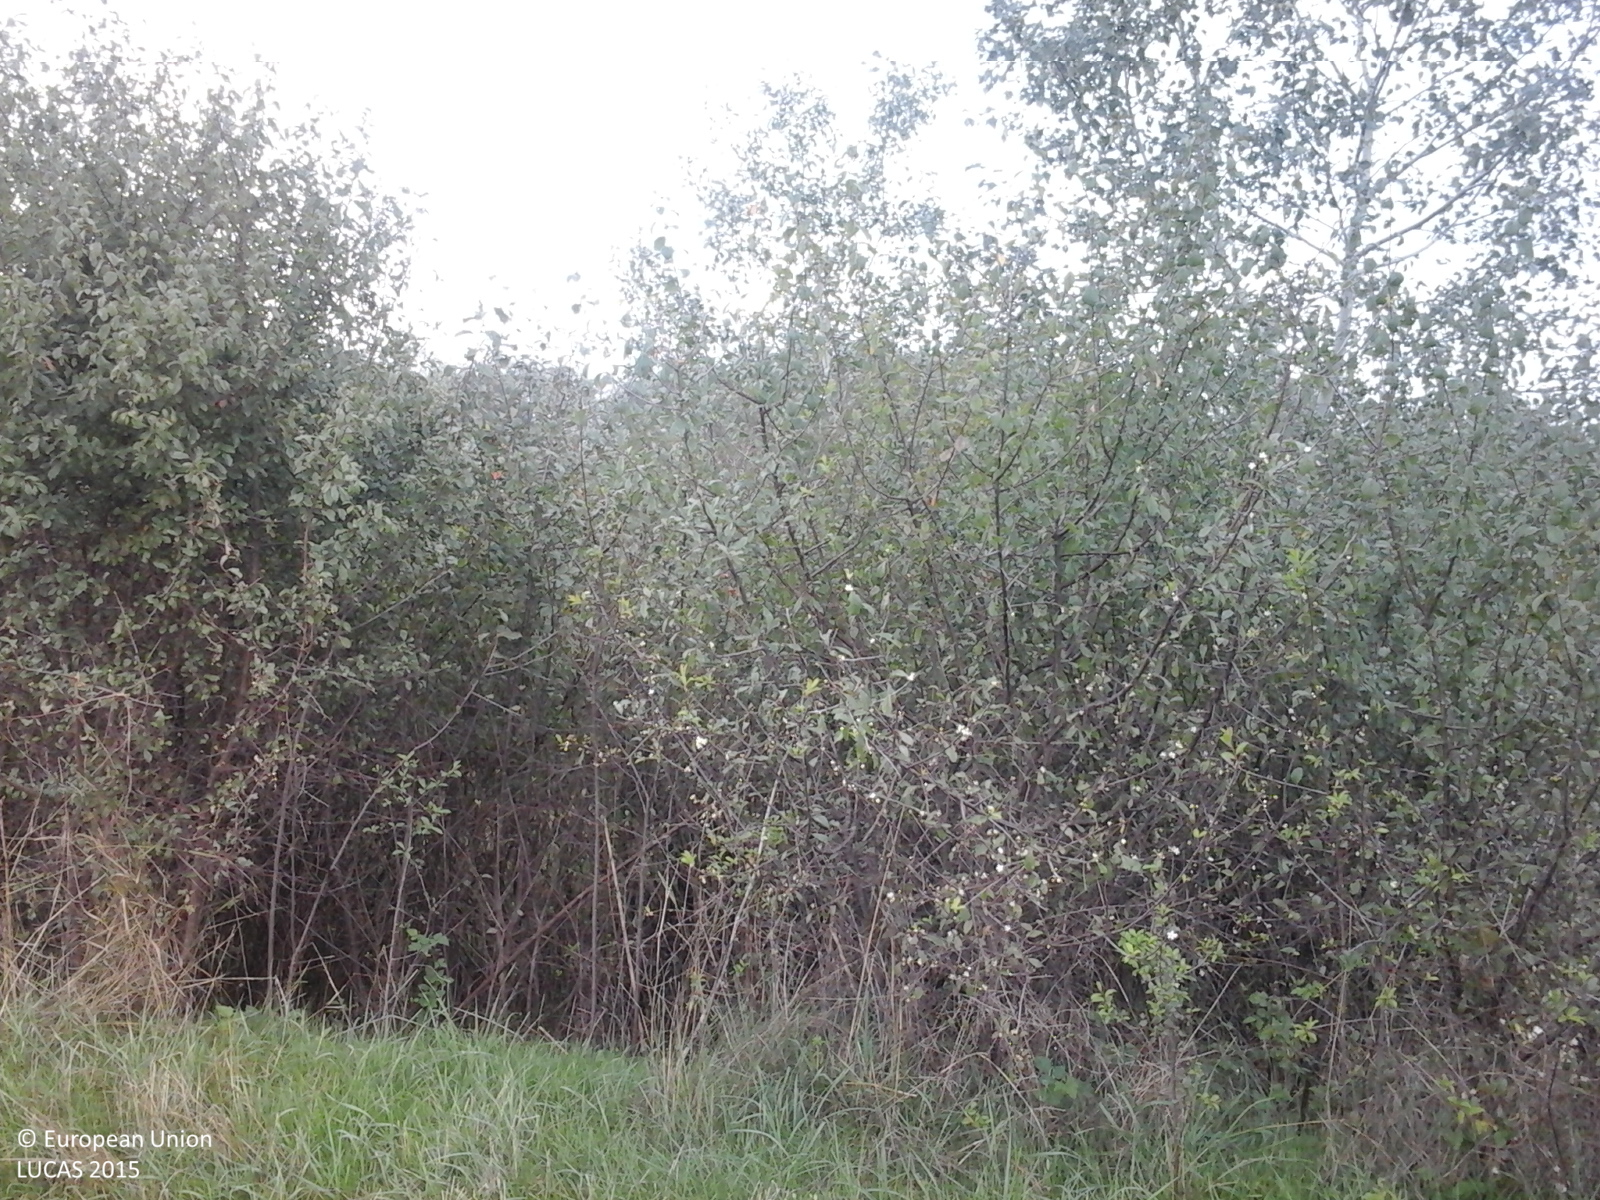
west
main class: Cropland
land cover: Maize
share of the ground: > 75 %
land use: Agriculture (excluding fallow land and kitchen gardens)
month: September
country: RO
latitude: 46.7111
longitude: 21.8291
